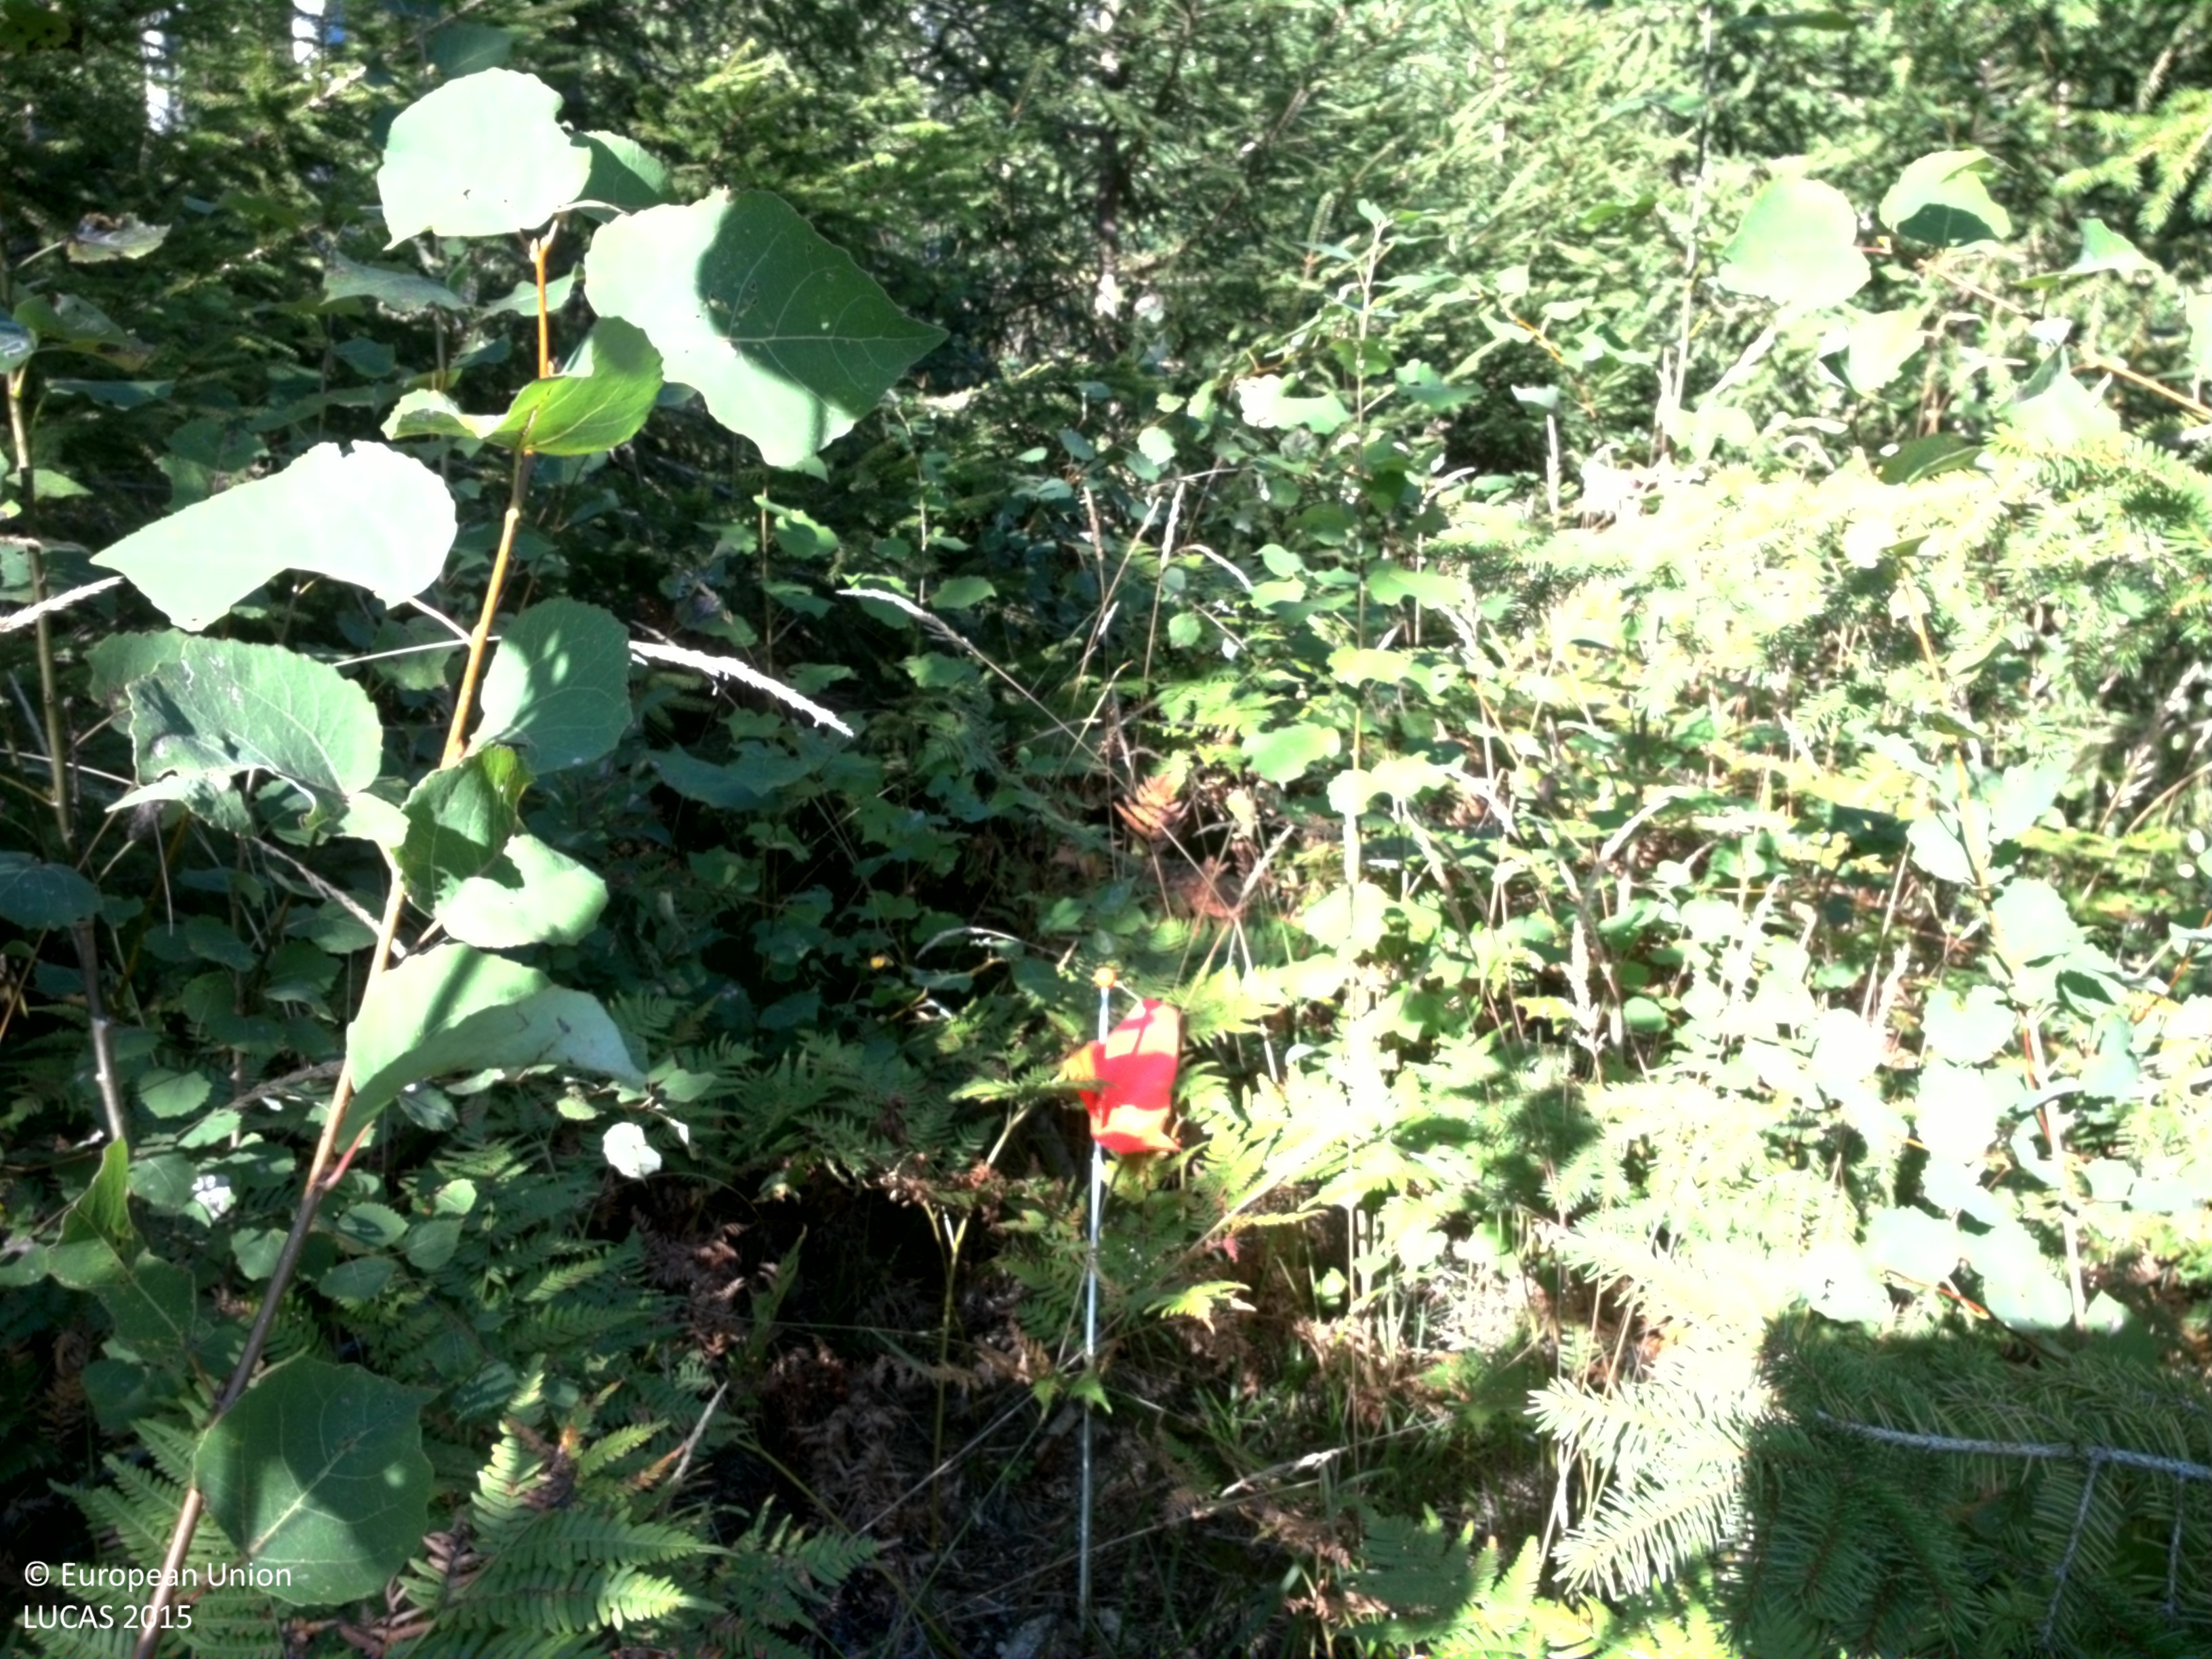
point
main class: Woodland
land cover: Spruce dominated mixed woodland
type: boreal forest
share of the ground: > 75 %
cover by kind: broadleaved forest trees 50 %, coniferous forest trees 40 %, herbaceous plants 10 %
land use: Forestry
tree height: > 5 m
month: August
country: SE
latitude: 59.5868
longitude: 15.9240
